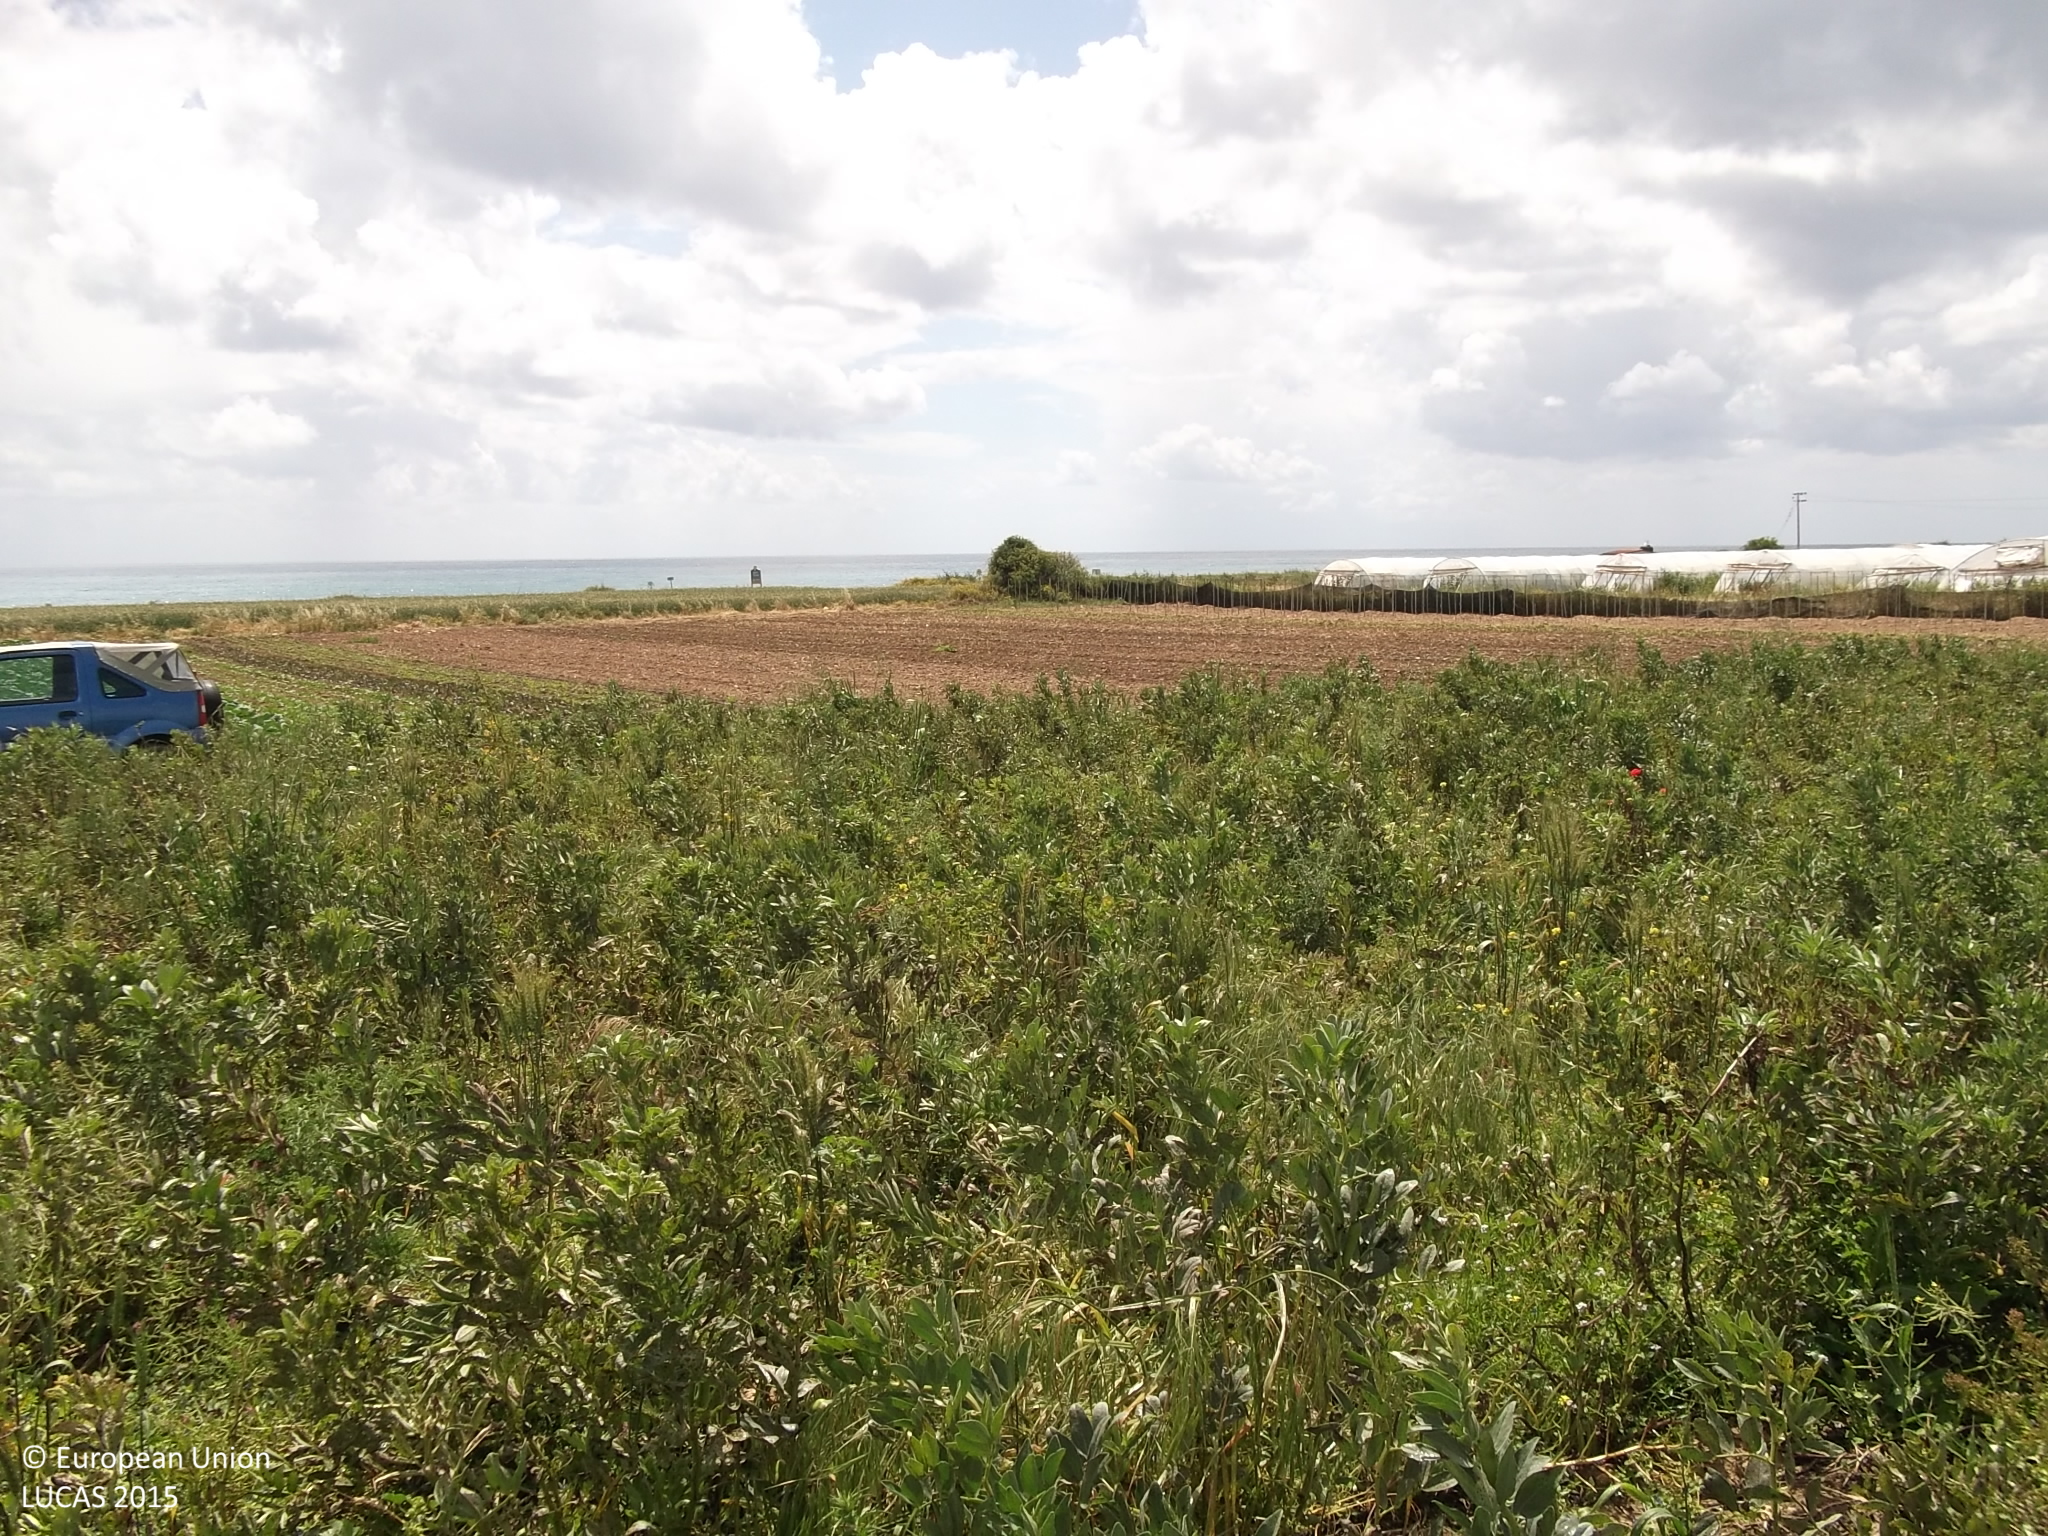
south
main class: Cropland
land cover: Dry pulses
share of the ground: > 75 %
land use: Agriculture (excluding fallow land and kitchen gardens)
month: April
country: CY
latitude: 34.7487
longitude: 33.3933
